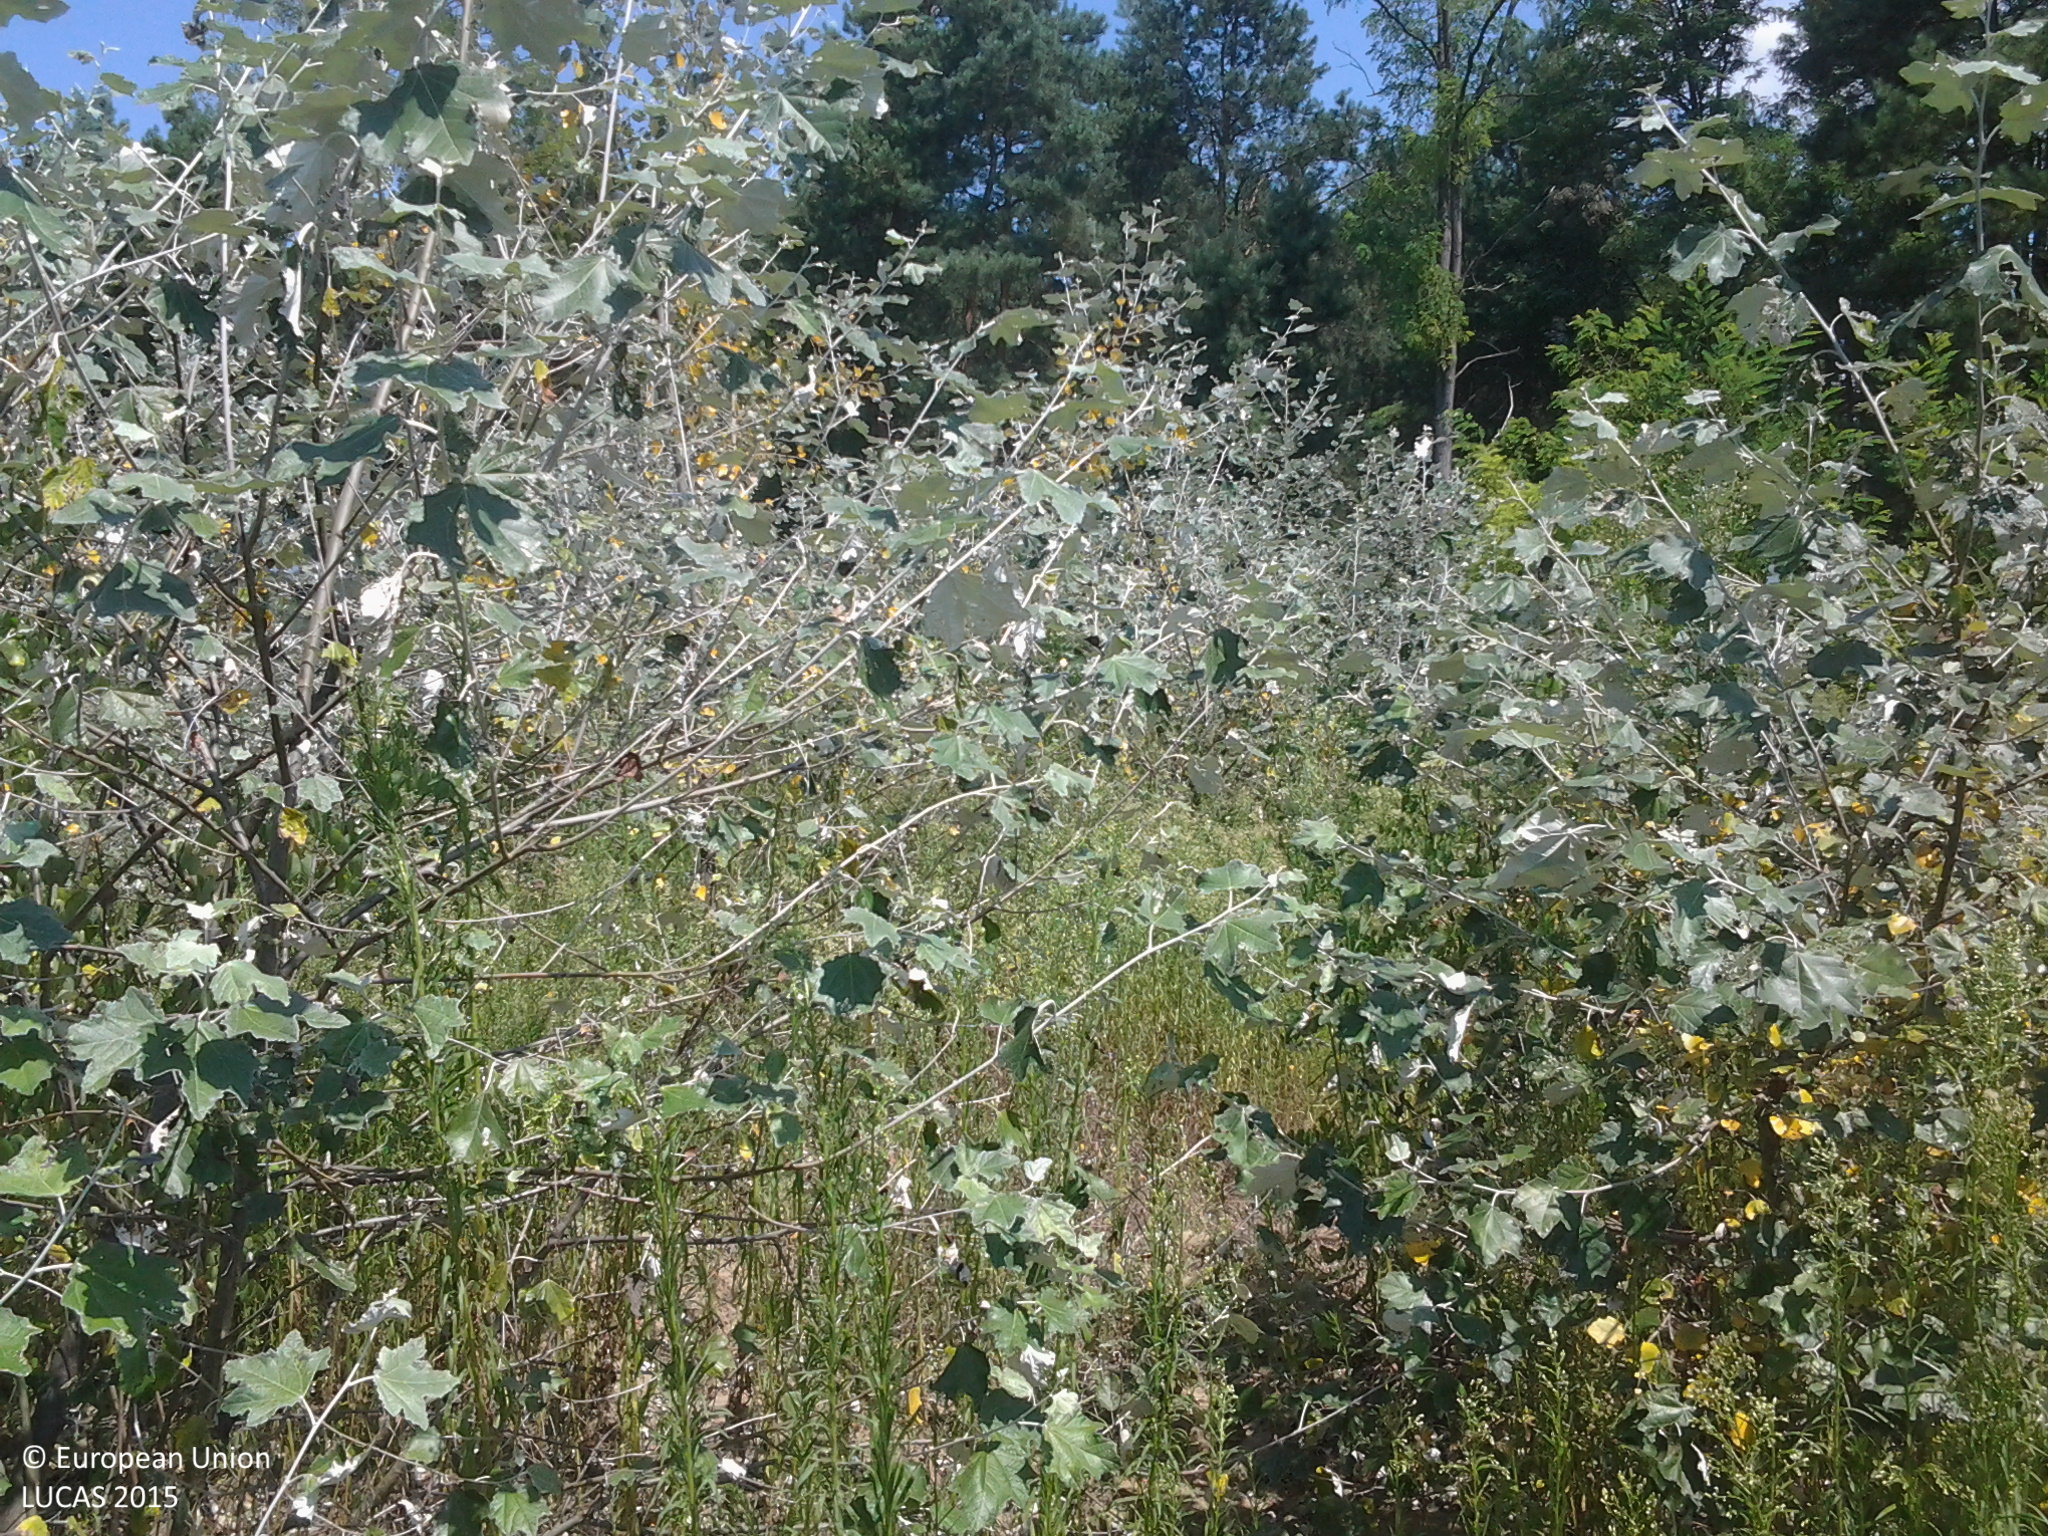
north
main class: Woodland
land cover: Broadleaved woodland
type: non-riverine alder, birch or aspen forest
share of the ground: 50 - 75 %
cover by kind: broadleaved forest trees 60 %, herbaceous plants 40 %
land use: Forestry
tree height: < 5 m
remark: Nursery
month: July
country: HU
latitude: 46.4418
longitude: 19.2176
